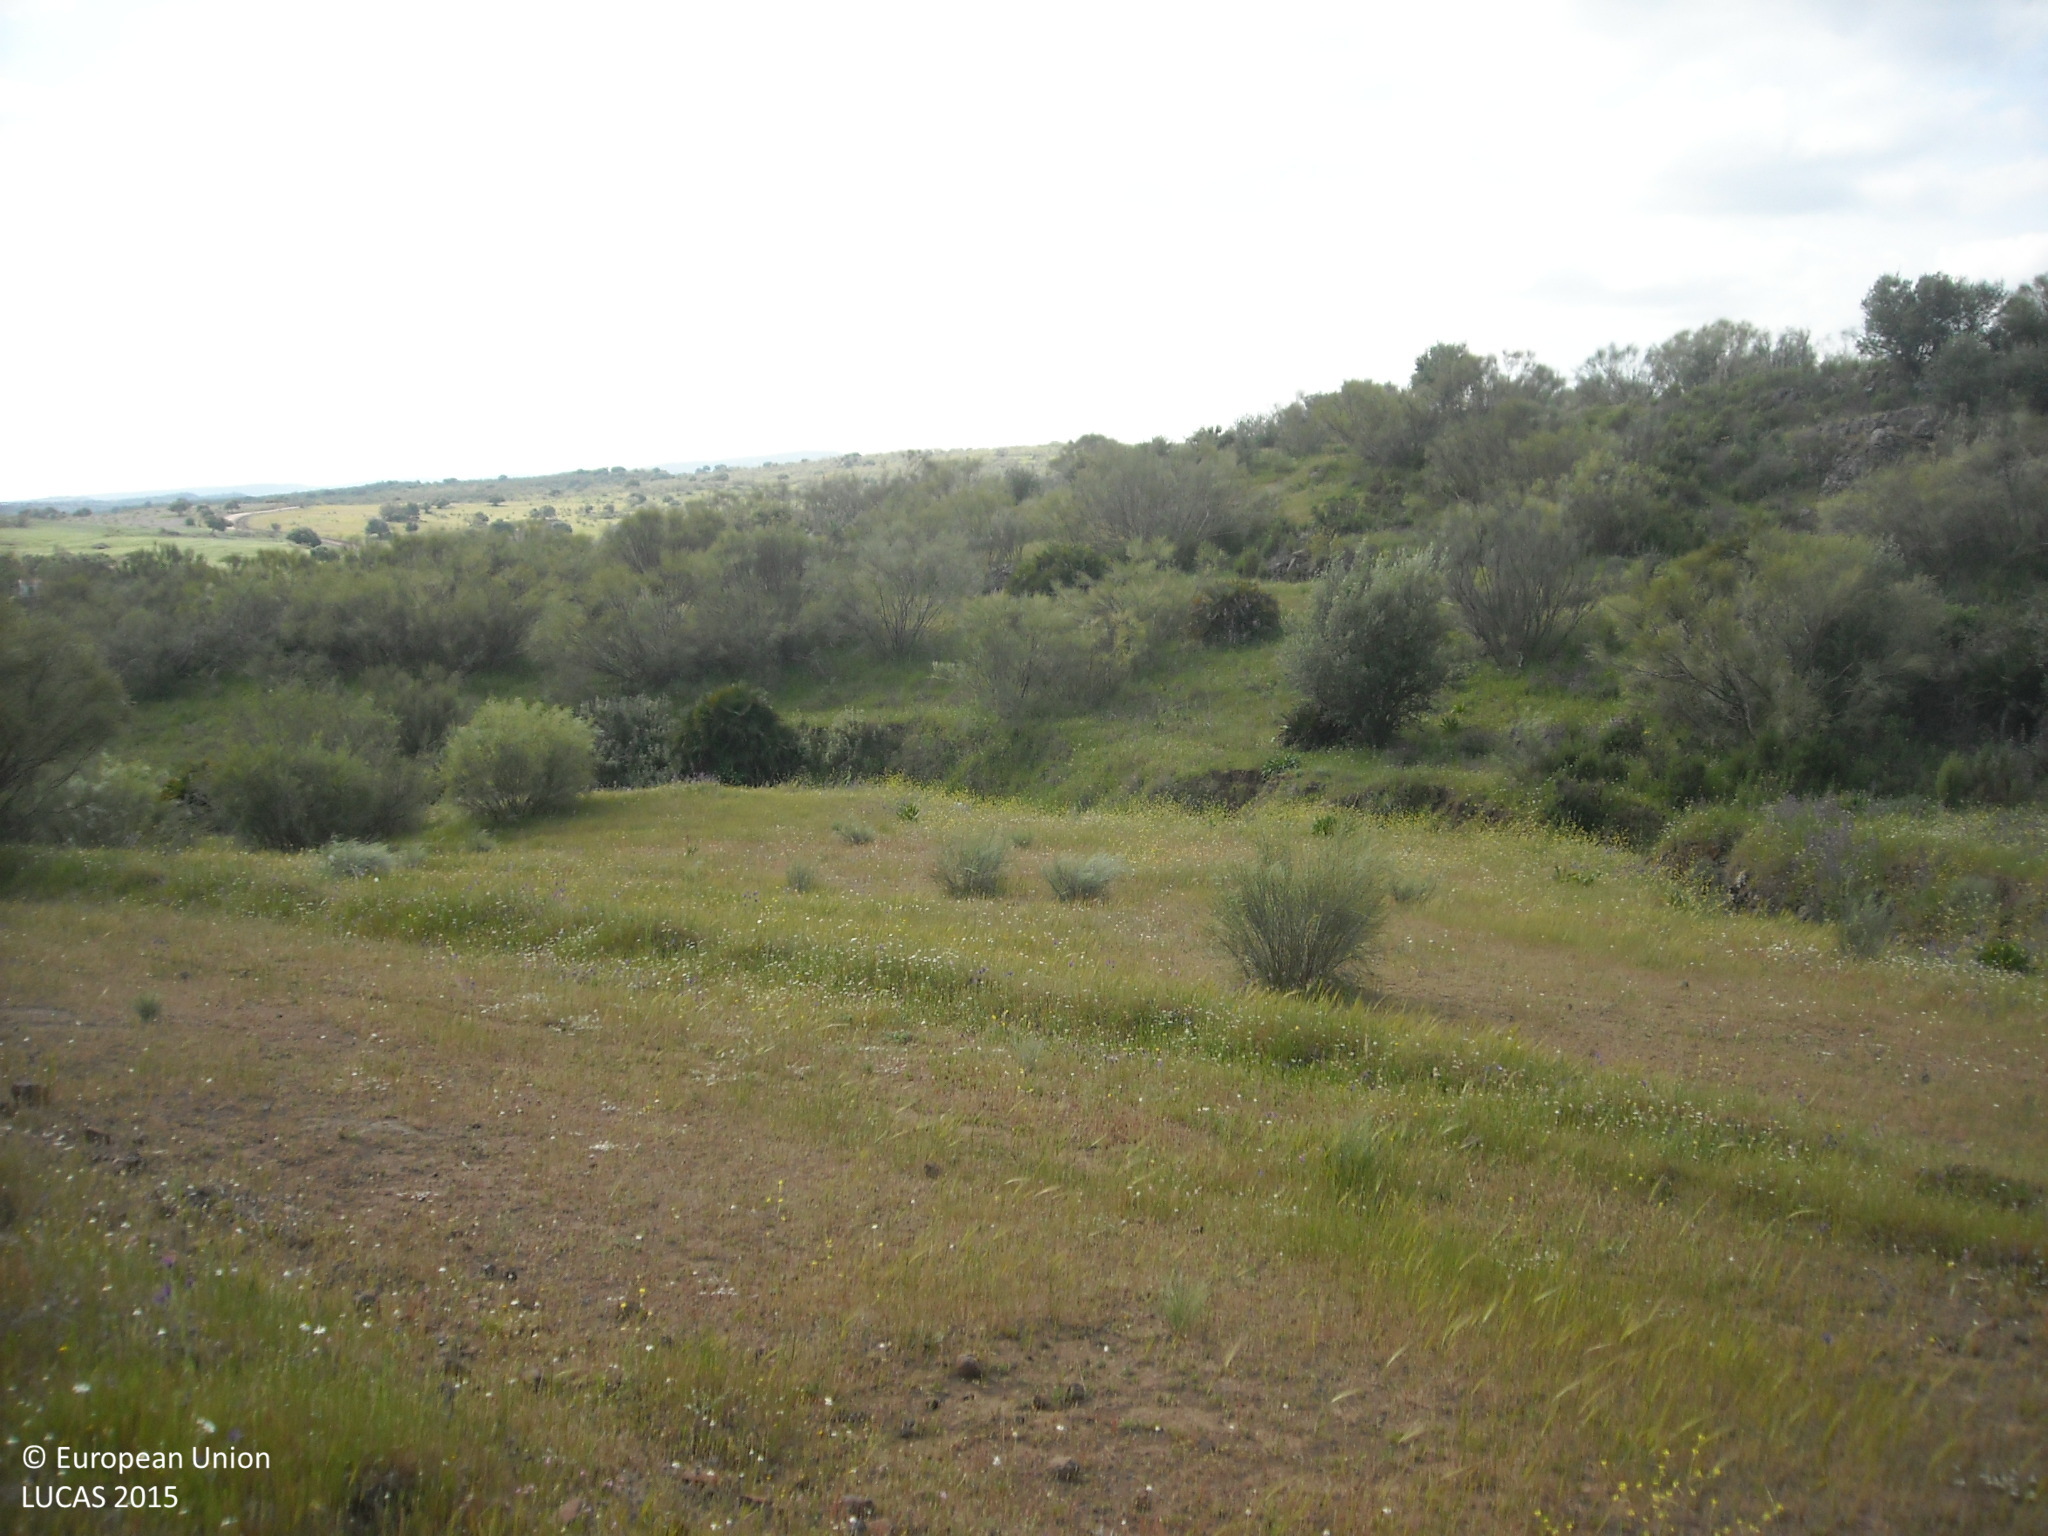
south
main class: Grassland
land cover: Grassland without tree/shrub cover
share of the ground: 50 - 75 %
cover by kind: herbaceous plants 70 %, consolidated bare surface 30 %
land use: Agriculture (excluding fallow land and kitchen gardens)
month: April
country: ES
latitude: 37.8578
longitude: -6.0019
